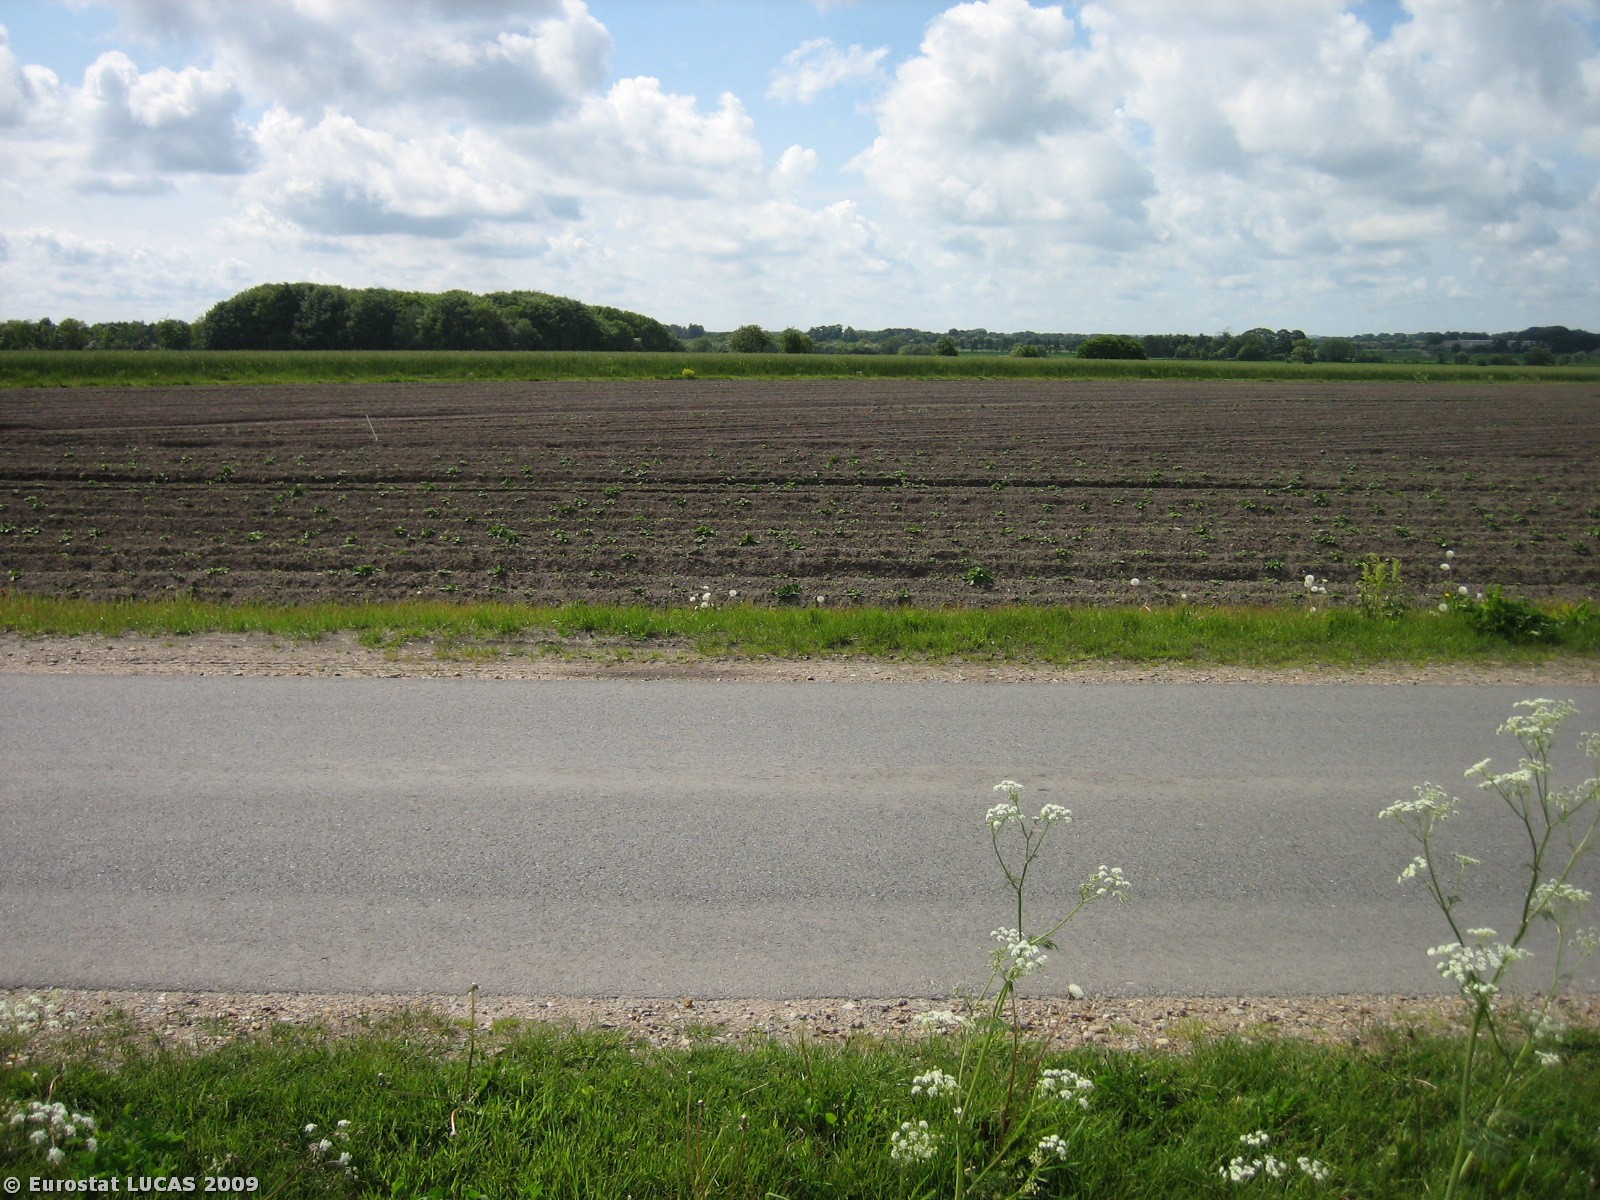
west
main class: Grassland
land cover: Grassland without tree/shrub cover
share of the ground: > 75 %
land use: Unused
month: May
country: DK
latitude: 55.9850
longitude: 8.8632
